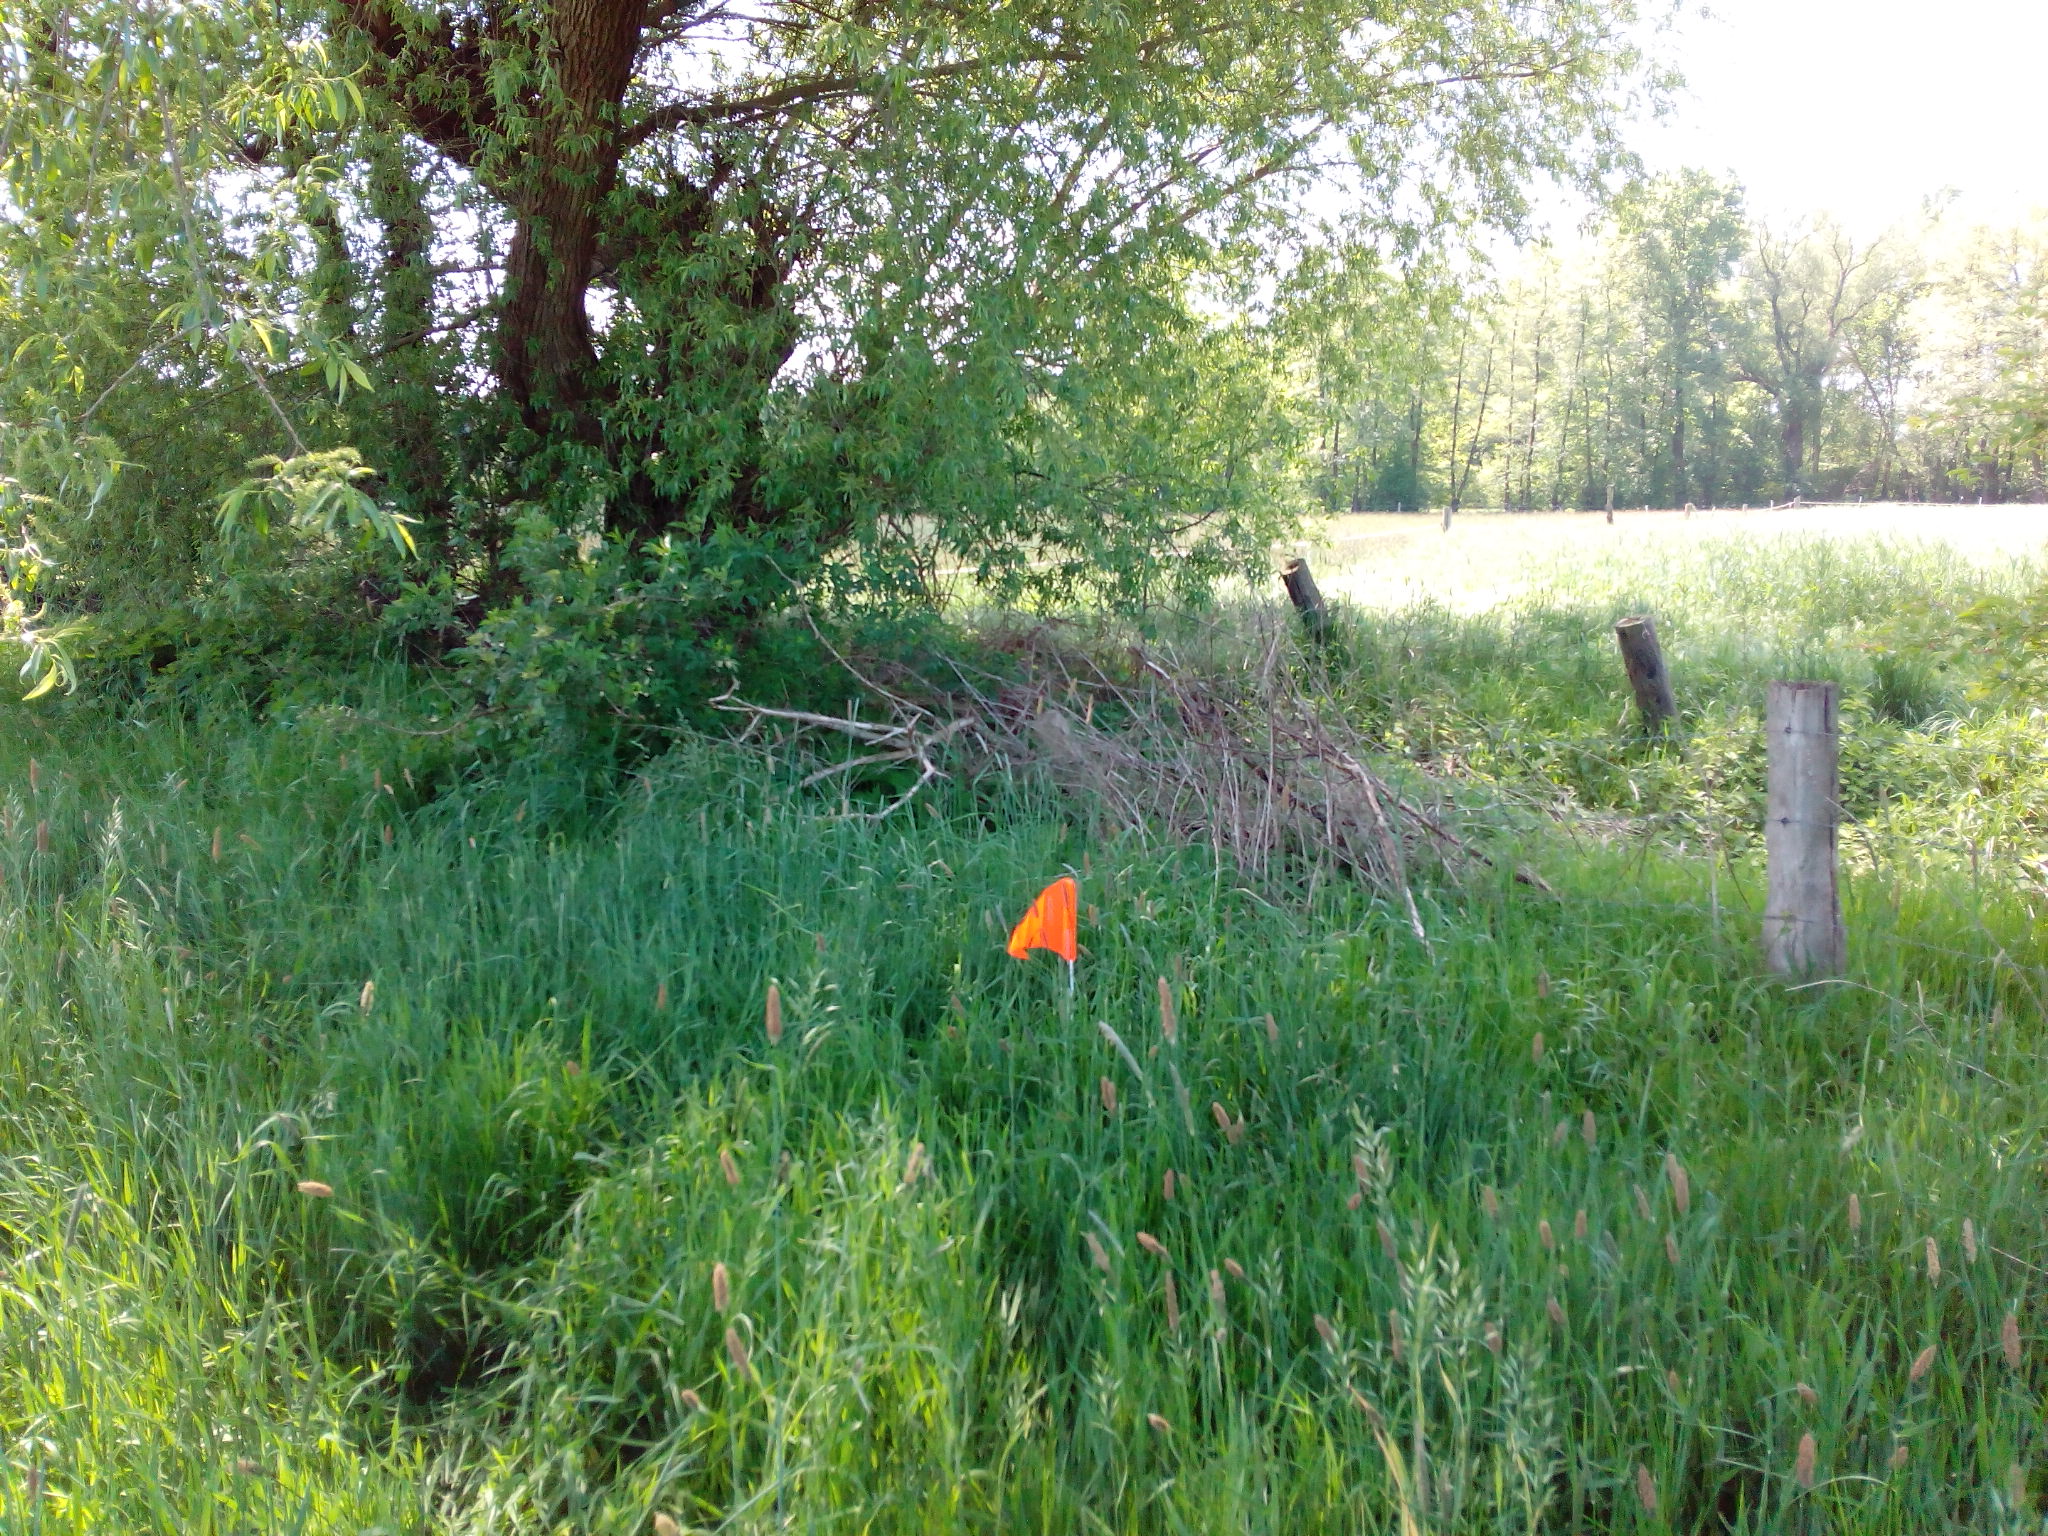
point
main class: Woodland
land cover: Broadleaved woodland
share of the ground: > 75 %
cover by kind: broadleaved forest trees 100 %
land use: Agriculture (excluding fallow land and kitchen gardens)
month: May
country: DE
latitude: 52.4308
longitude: 9.6324
